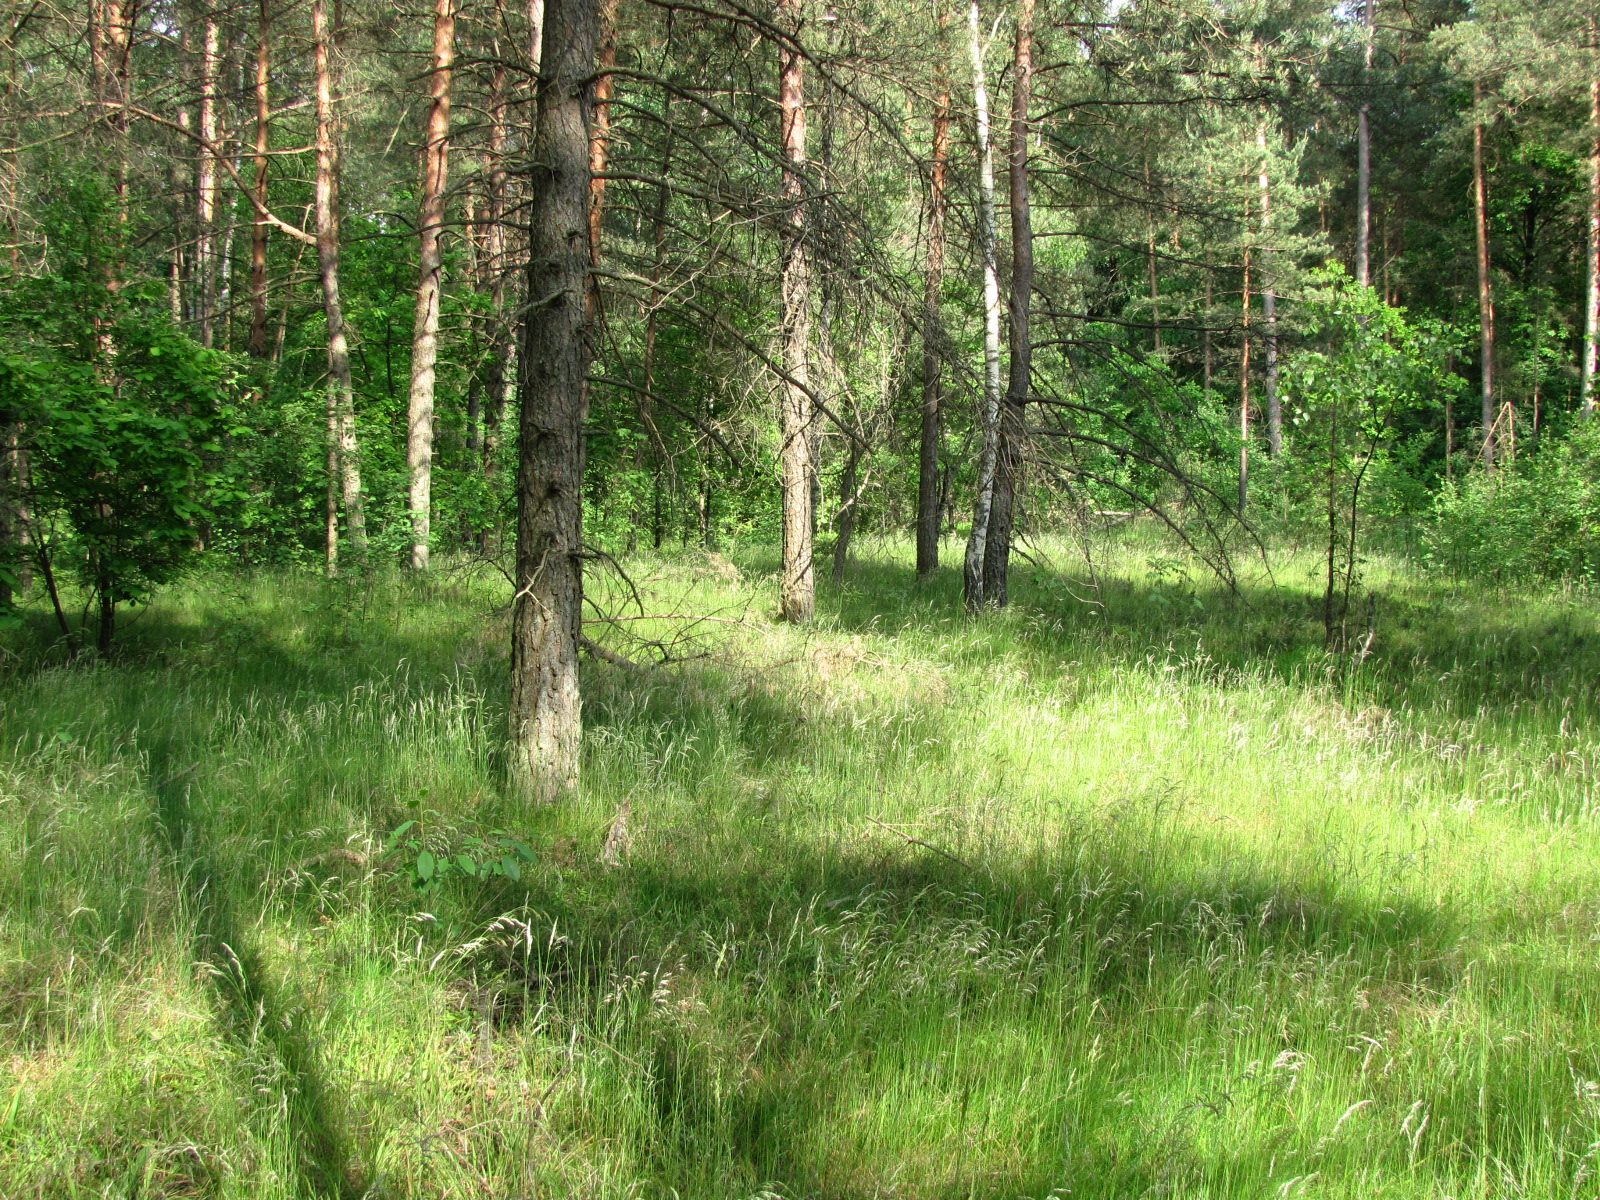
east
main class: Woodland
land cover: Pine dominated coniferous woodland
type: hemiboreal forest and nemoral coniferous forest and mixed broadleaved-coniferous forest
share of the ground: > 75 %
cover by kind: coniferous forest trees 75 %, herbaceous plants 25 %
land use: Forestry
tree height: > 5 m
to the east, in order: Pine dominated coniferous woodland; Pine dominated mixed woodland; Abandoned hedges; Inland fresh running water; Abandoned hedges; Pine dominated mixed woodland; Broadleaved woodland
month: June
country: LV
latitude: 56.9394
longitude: 24.2732
